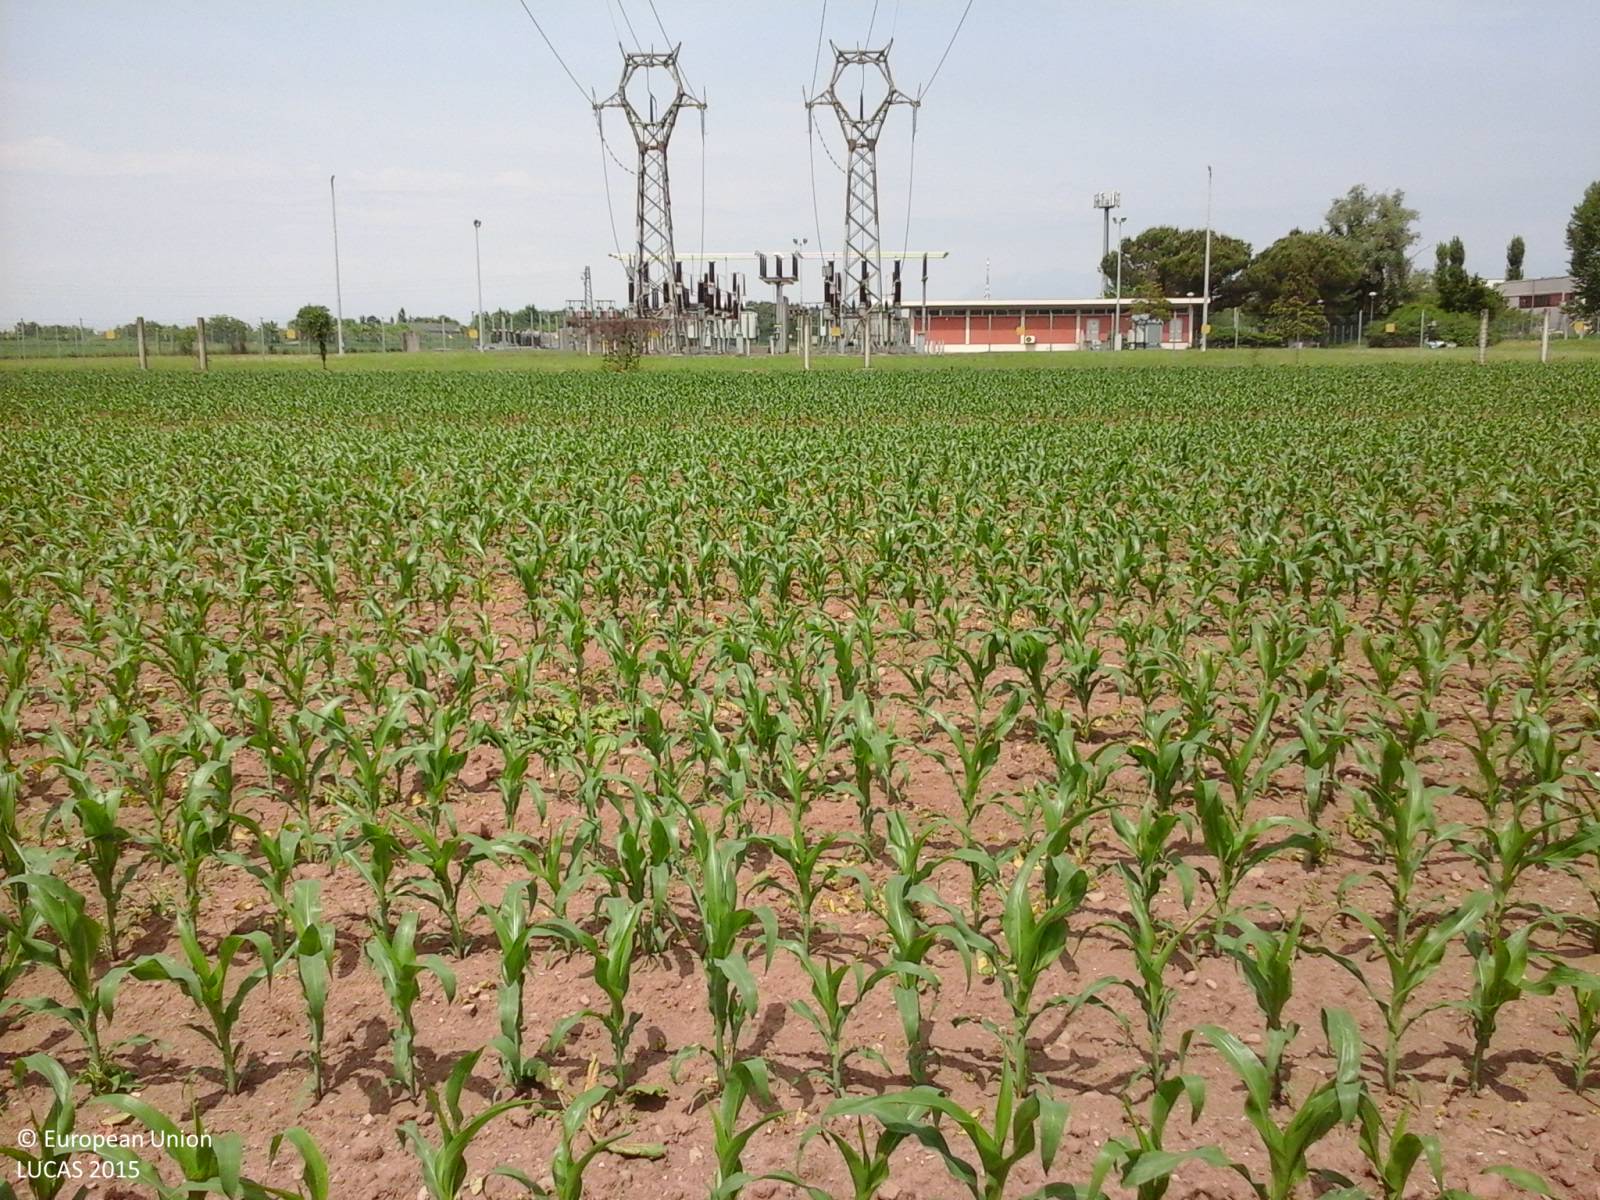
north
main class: Cropland
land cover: Maize
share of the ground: 50 - 75 %
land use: Agriculture (excluding fallow land and kitchen gardens)
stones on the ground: < 10 %
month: May
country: IT
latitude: 46.0130
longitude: 13.2639
